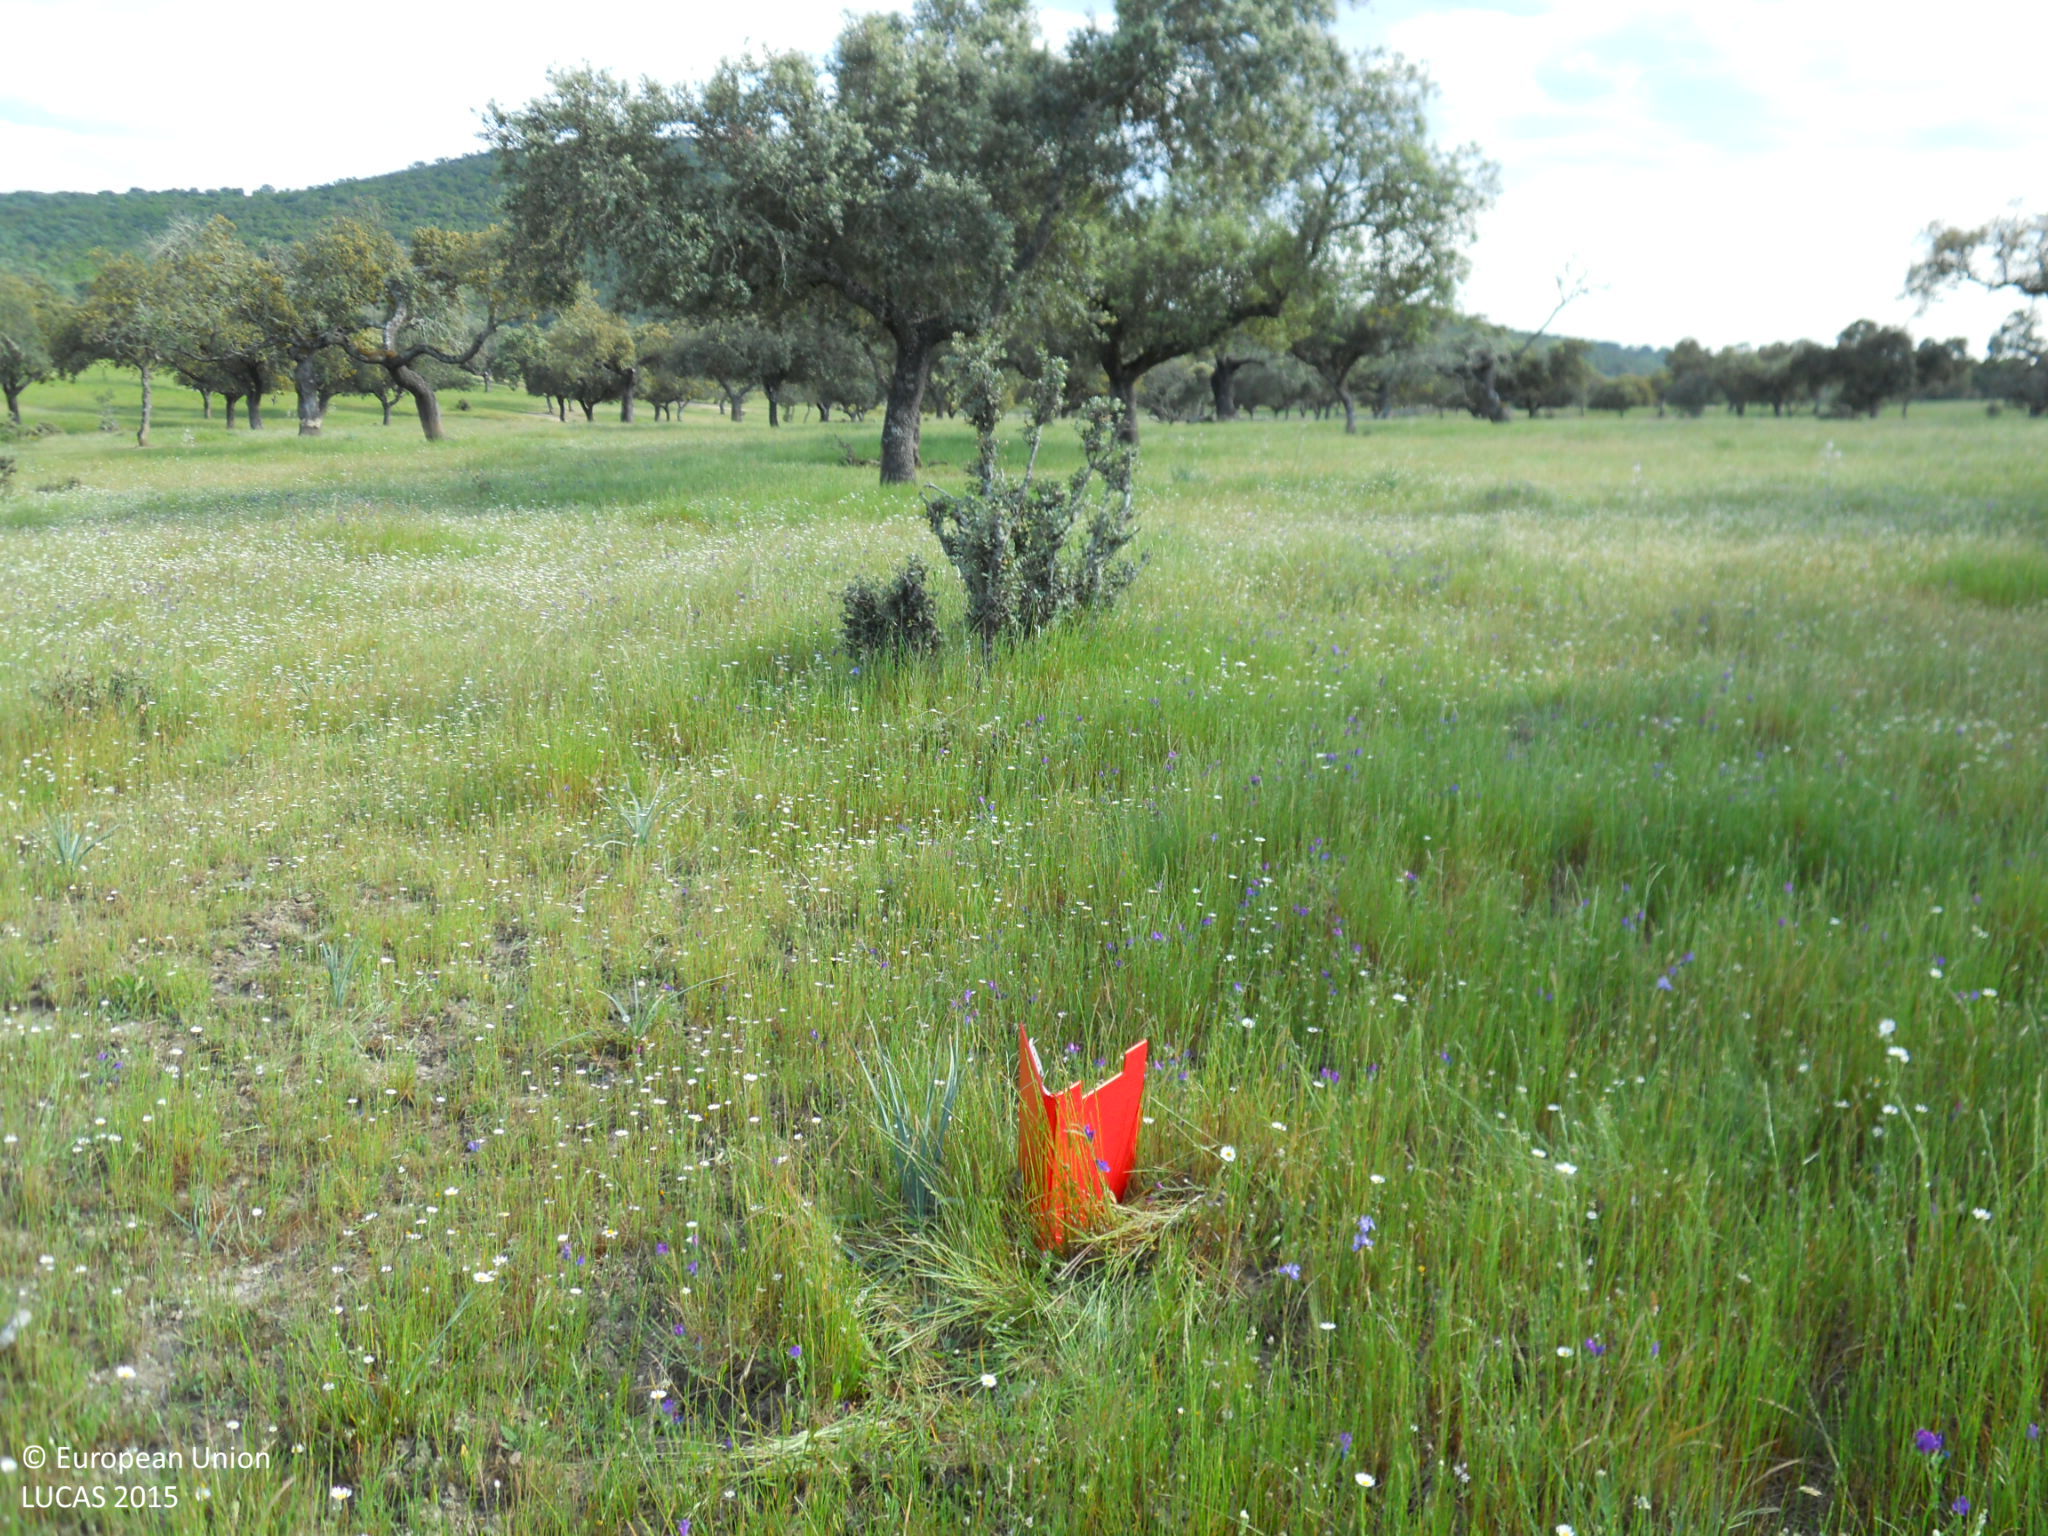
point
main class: Woodland
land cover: Broadleaved woodland
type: broadleaved evergreen forest
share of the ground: 10 - 25 %
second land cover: Grassland without tree/shrub cover
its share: > 75 %
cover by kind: herbaceous plants 65 %, broadleaved forest trees 35 %
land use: Forestry
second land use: Agriculture (excluding fallow land and kitchen gardens)
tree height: > 5 m
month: April
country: ES
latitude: 39.2857
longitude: -6.8030
